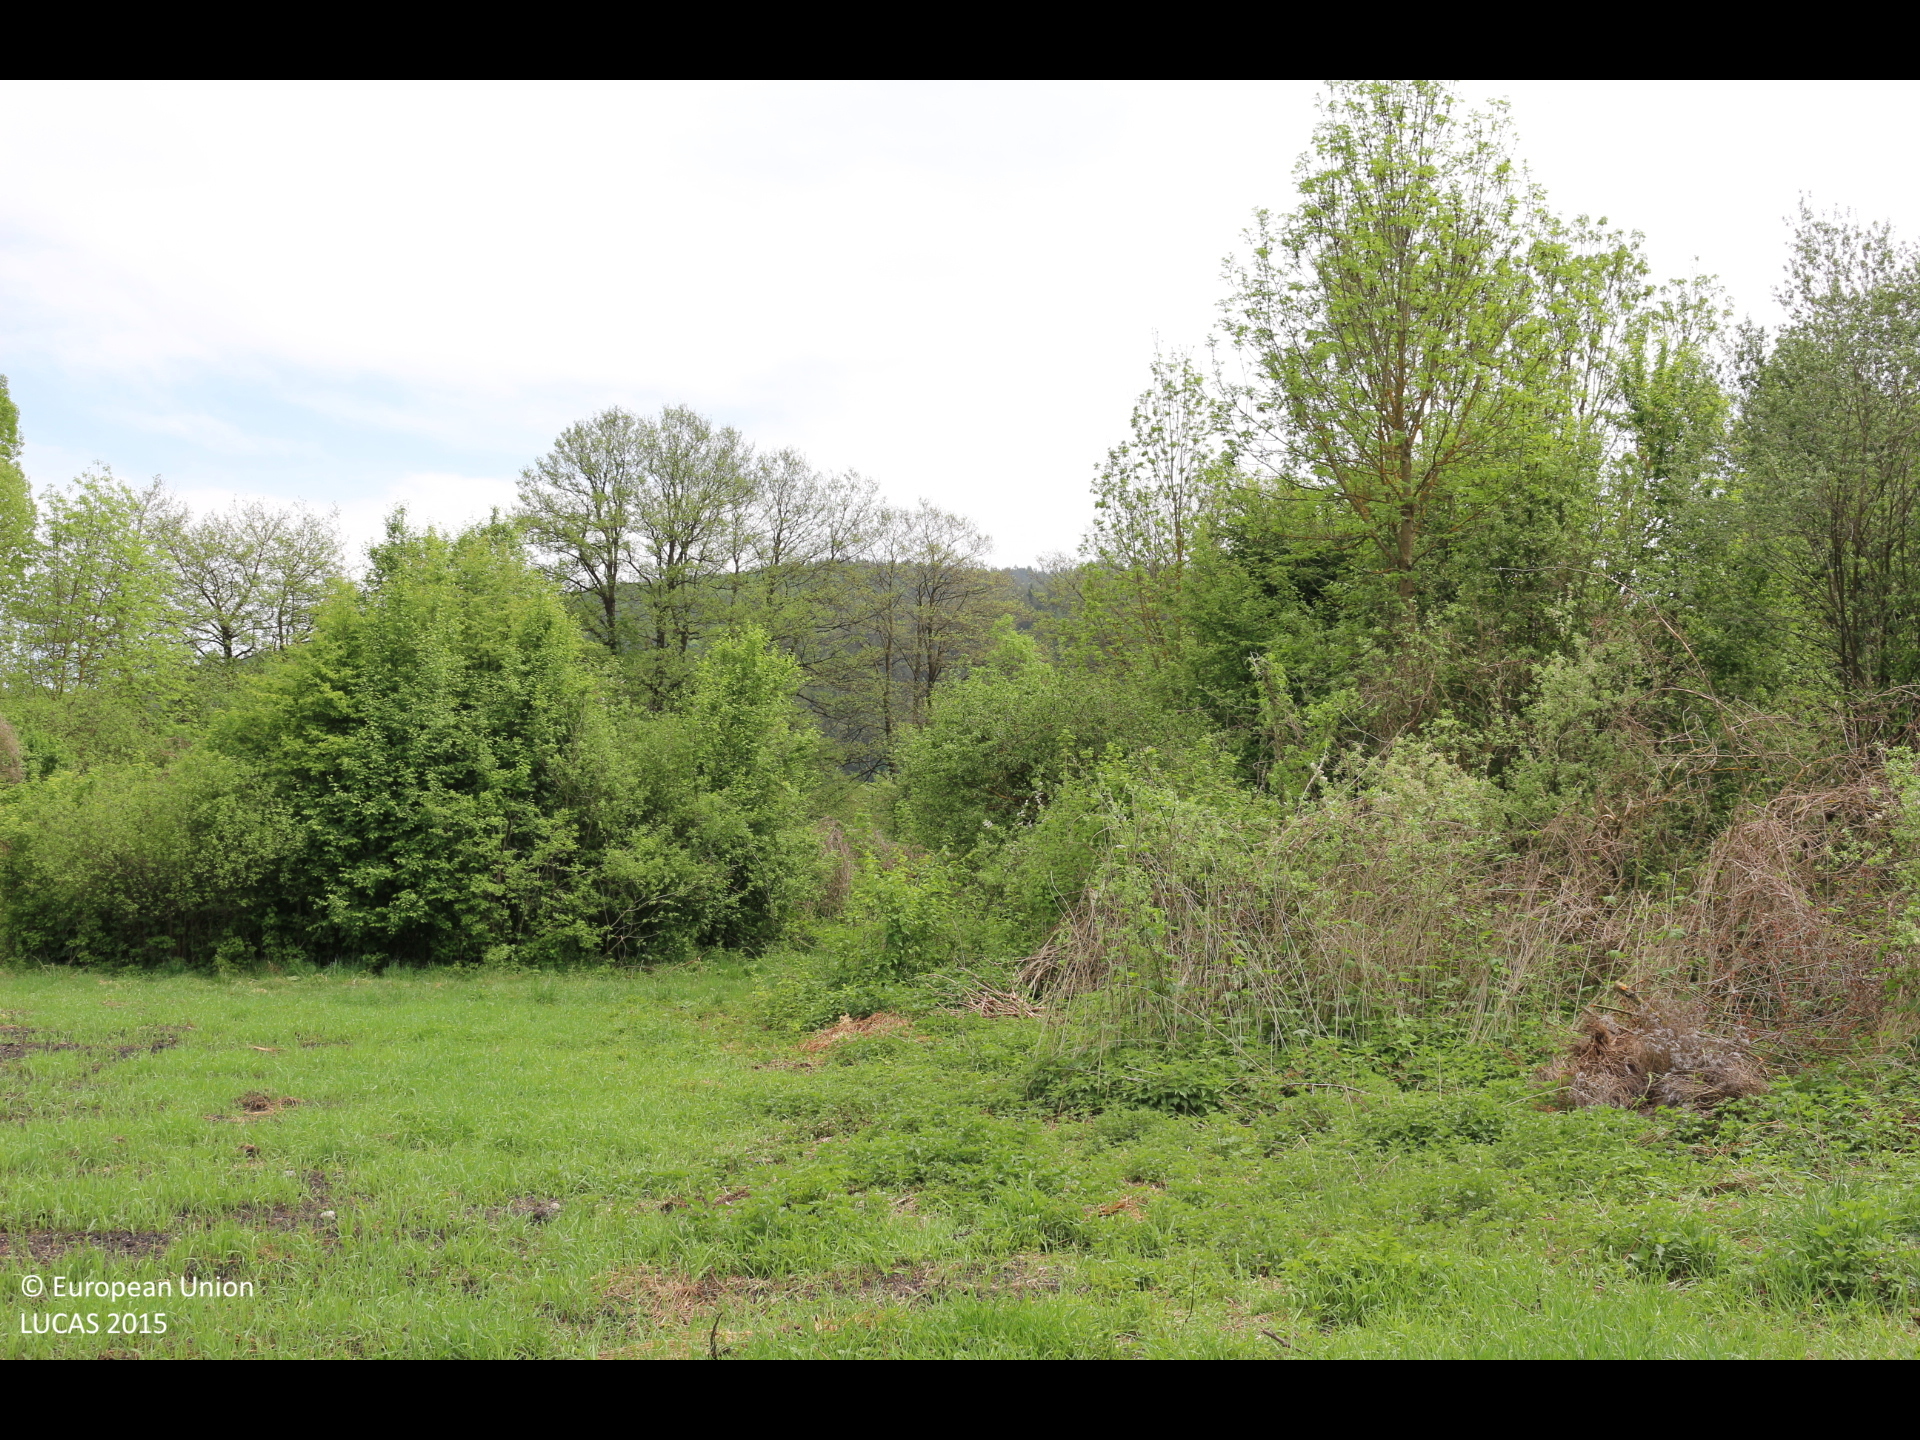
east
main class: Cropland
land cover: Common wheat
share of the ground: 25 - 50 %
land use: Agriculture (excluding fallow land and kitchen gardens)
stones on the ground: < 10 %
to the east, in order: Common wheat; Grass margins; Tracks; Broadleaved woodland; Grassland without tree/shrub cover; Other bare soil
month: May
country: AT
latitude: 46.6786
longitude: 14.3247
